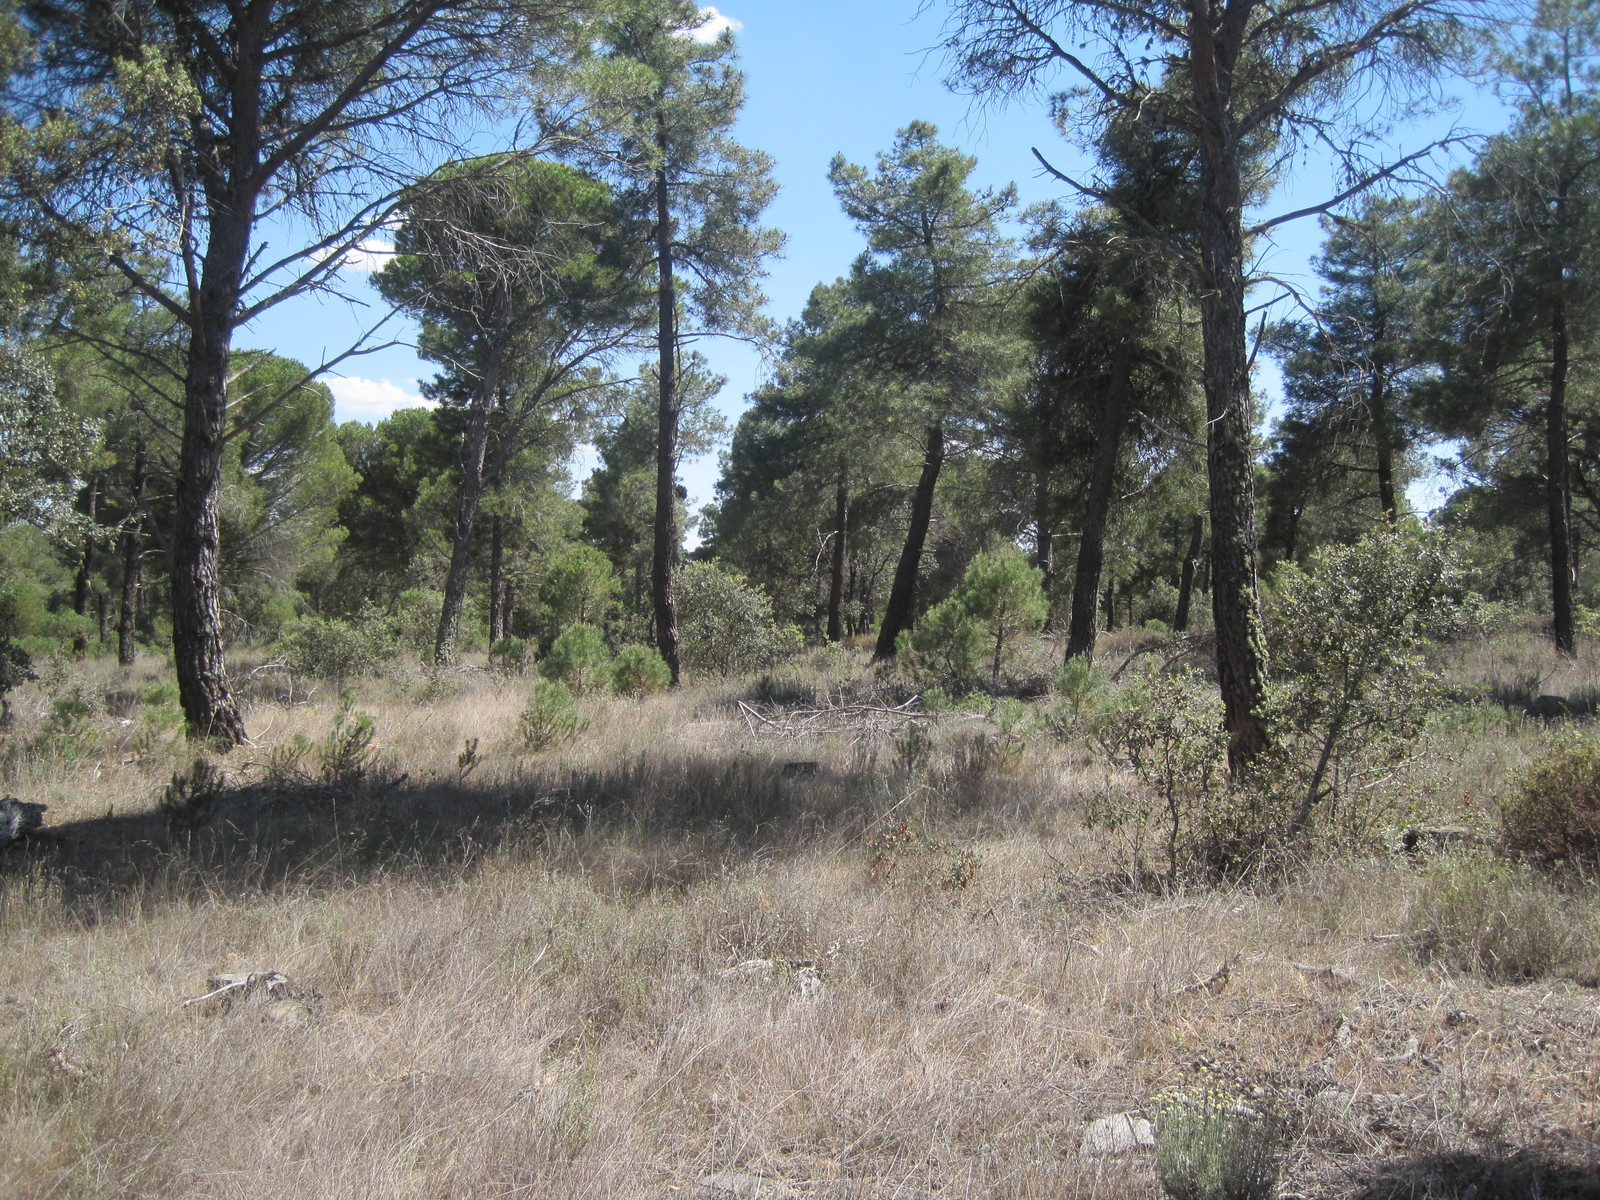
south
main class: Woodland
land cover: Pine dominated coniferous woodland
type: hemiboreal forest and nemoral coniferous forest and mixed broadleaved-coniferous forest
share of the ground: 50 - 75 %
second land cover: Grassland without tree/shrub cover
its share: > 75 %
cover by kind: coniferous forest trees 65 %, herbaceous plants 25 %, shrubs 10 %
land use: Forestry
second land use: Agriculture (excluding fallow land and kitchen gardens)
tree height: > 5 m
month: June
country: ES
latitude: 41.7802
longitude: -5.3993
